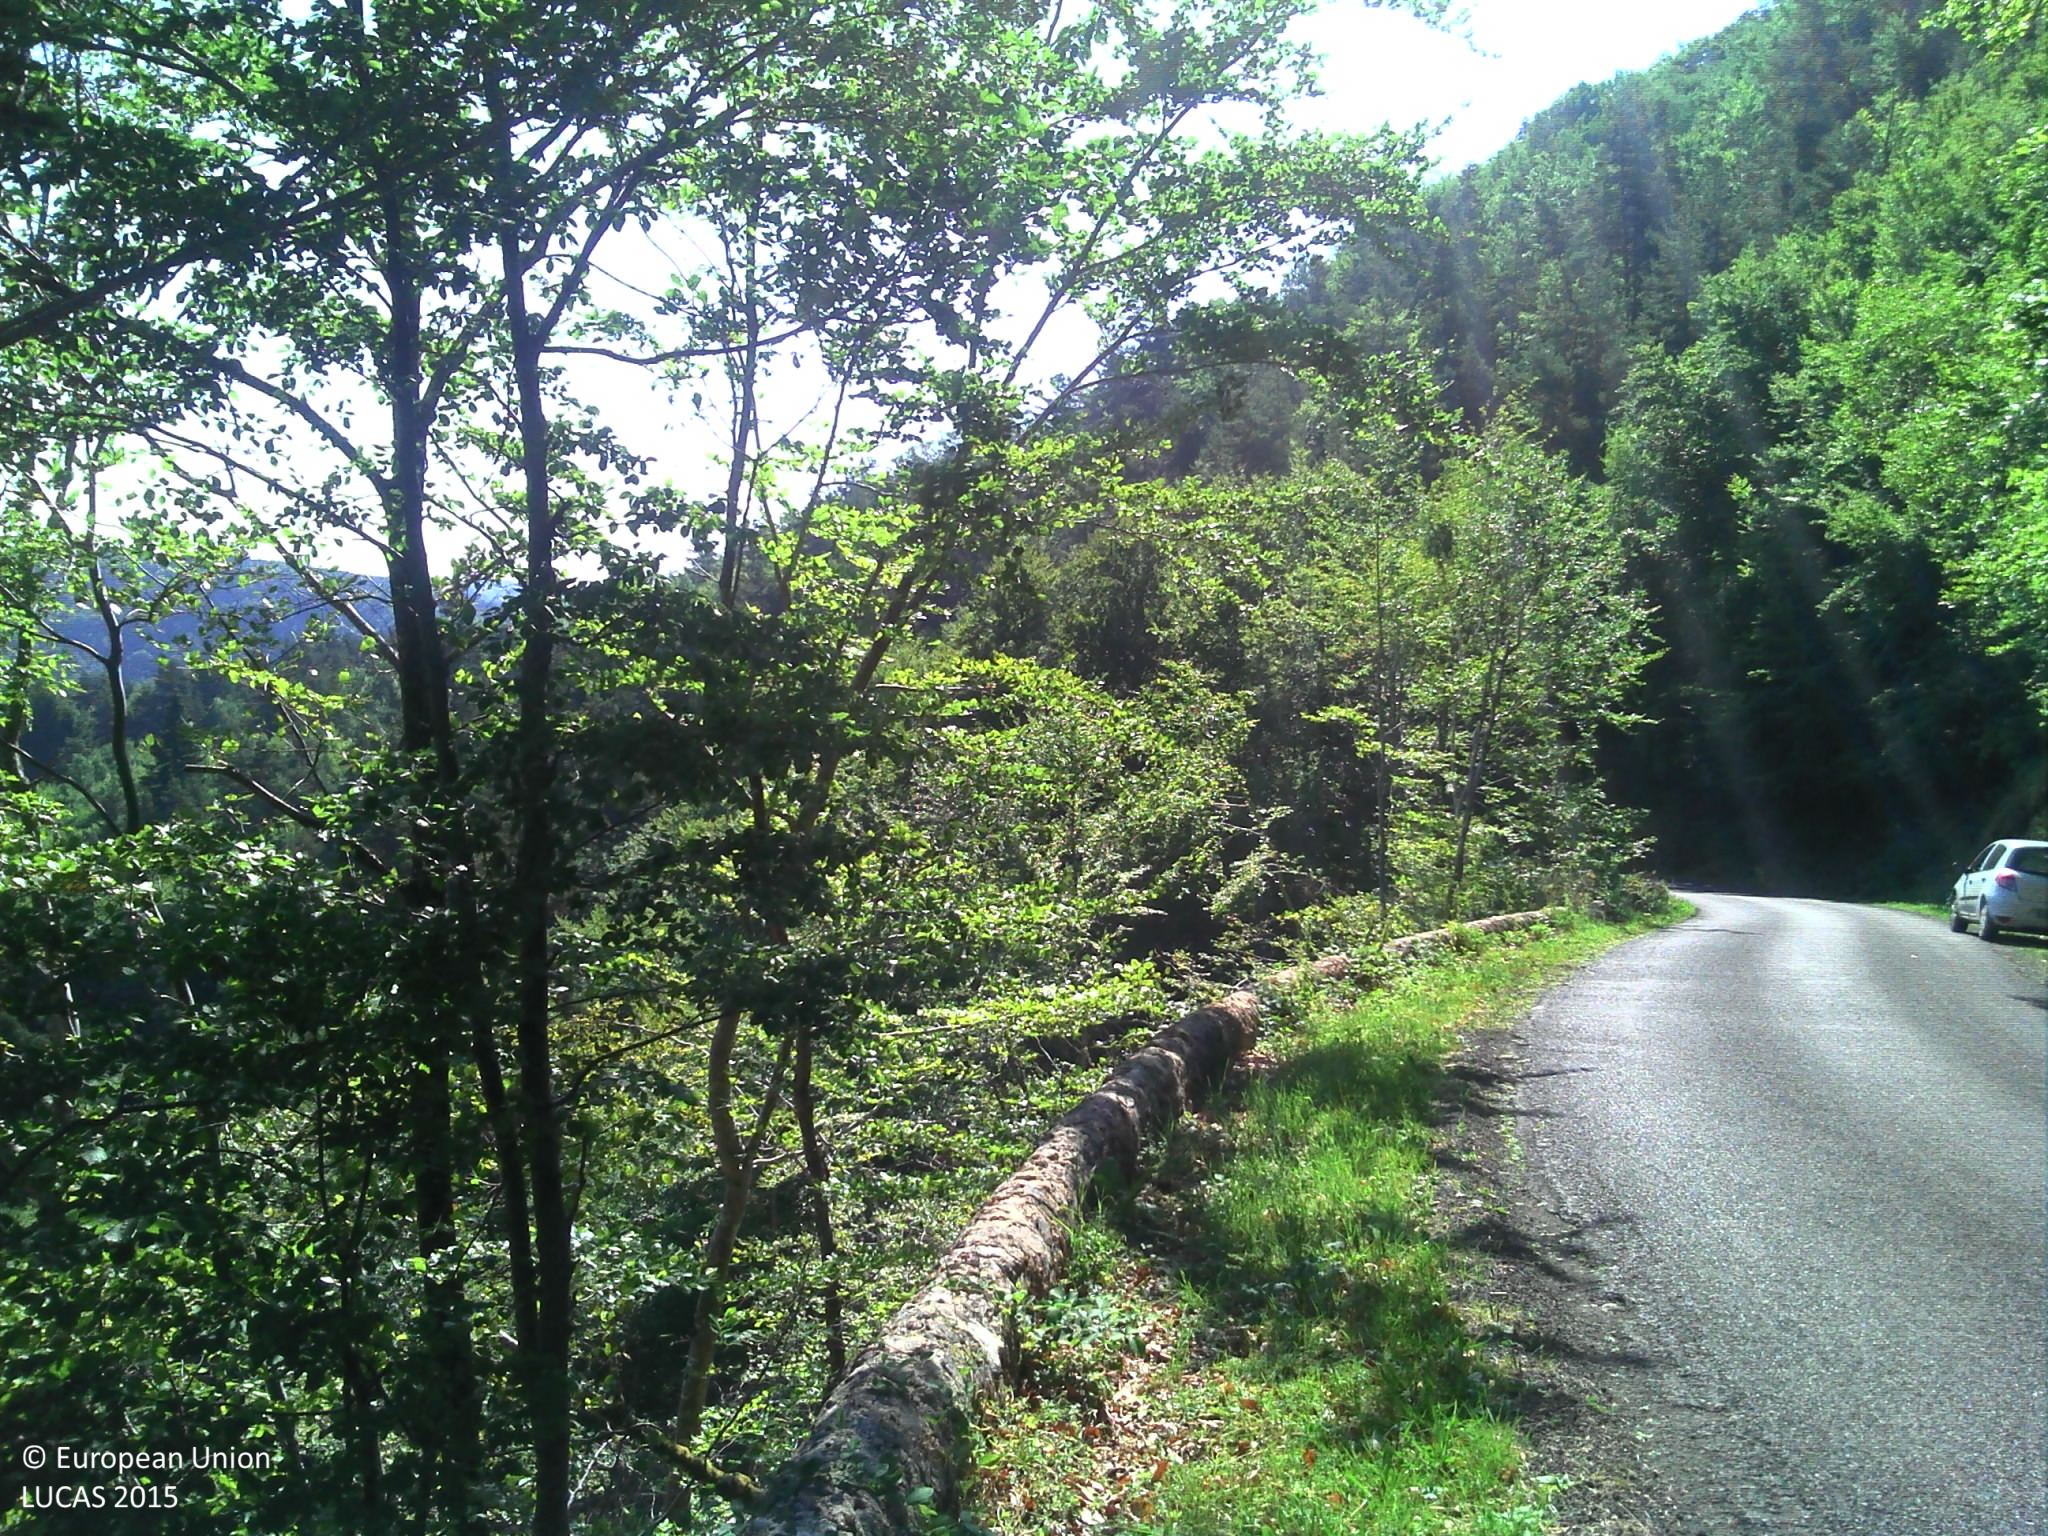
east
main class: Woodland
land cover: Broadleaved woodland
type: acidophilous oak and oak-birch forest
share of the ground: > 75 %
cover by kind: broadleaved forest trees 80 %, coniferous forest trees 10 %, shrubs 10 %
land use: Forestry
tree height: > 5 m
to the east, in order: Broadleaved woodland; Pine dominated mixed woodland; Ditches and canals; Pine dominated mixed woodland
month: August
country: FR
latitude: 45.2168
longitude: 3.8530
